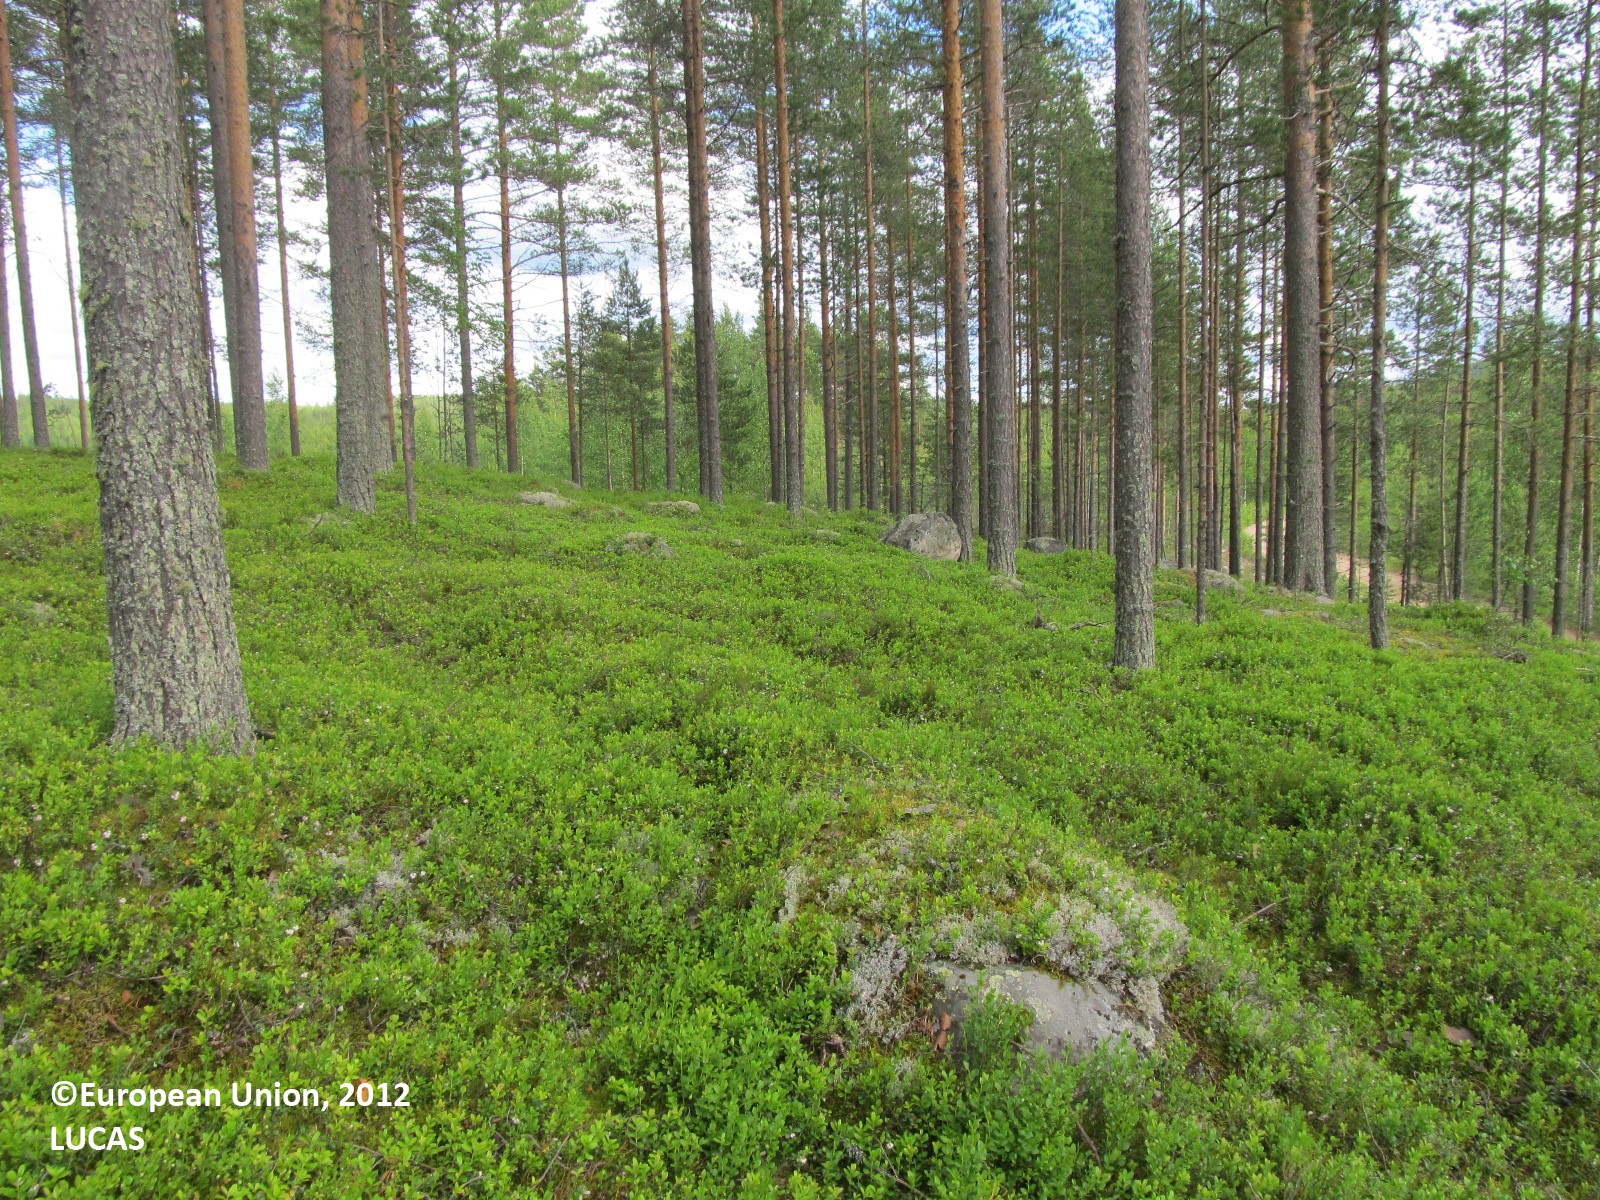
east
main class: Woodland
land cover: Pine dominated coniferous woodland
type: boreal forest
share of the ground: 50 - 75 %
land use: Forestry
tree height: > 5 m
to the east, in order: Pine dominated coniferous woodland
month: June
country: FI
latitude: 62.9141
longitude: 28.8519
